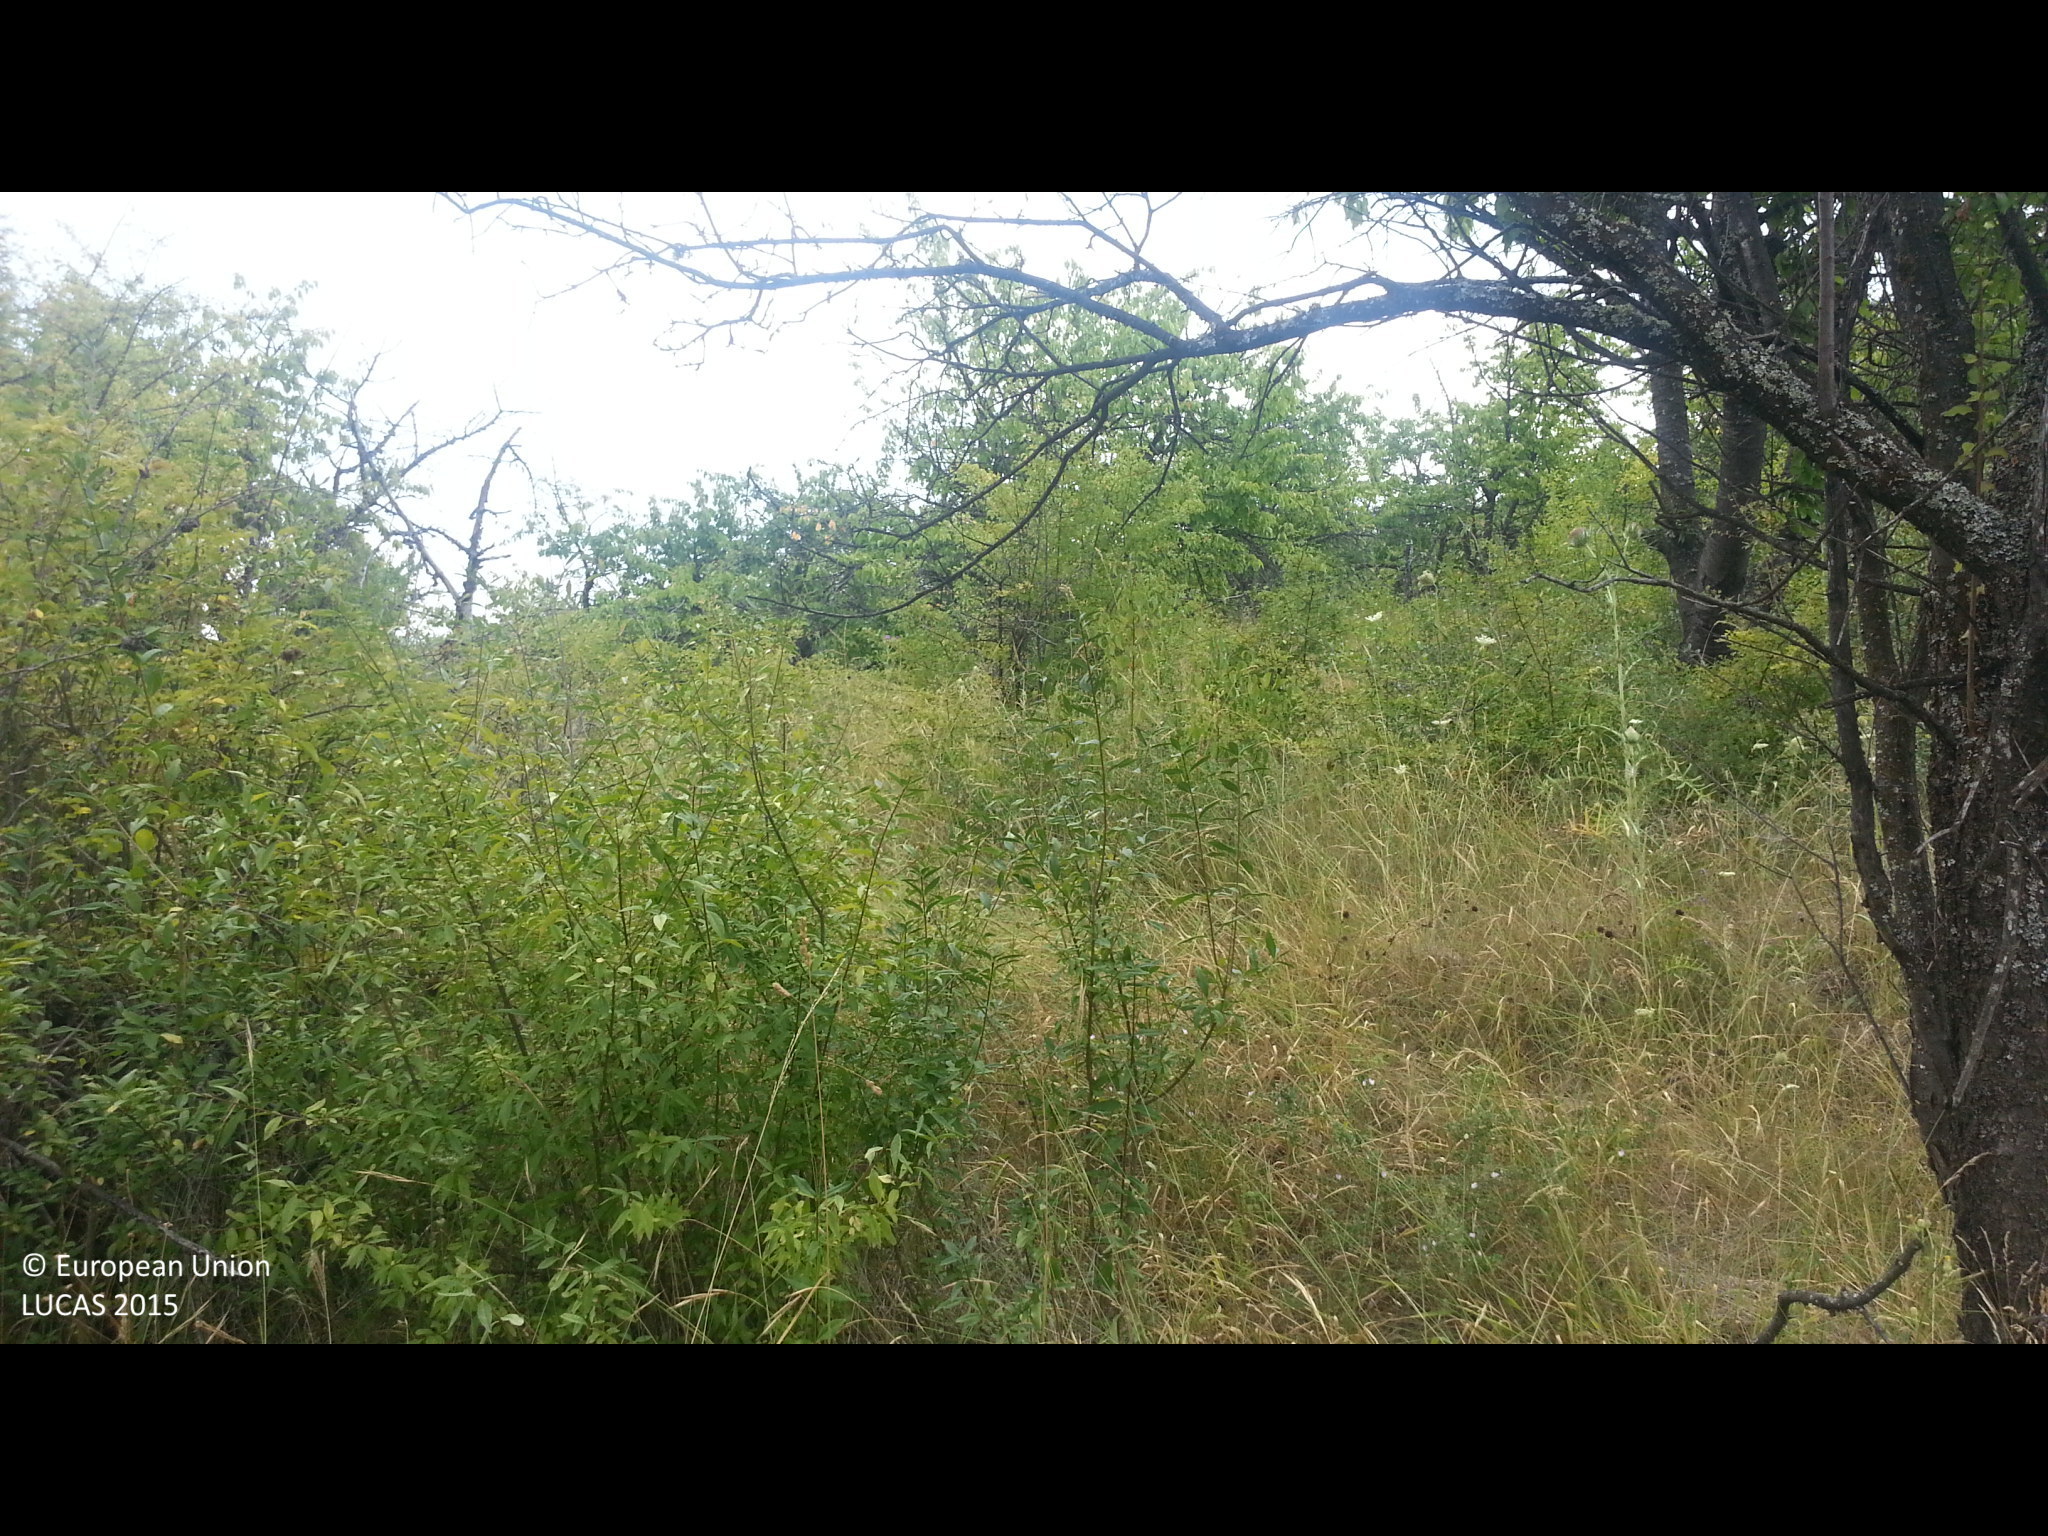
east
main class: Cropland
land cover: Cherry fruit
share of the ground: 25 - 50 %
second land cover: Shrubland without tree cover
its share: 50 - 75 %
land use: Agriculture (excluding fallow land and kitchen gardens)
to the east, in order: Cherry fruit; Shrubland without tree cover
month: August
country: BG
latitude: 42.2421
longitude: 22.7836
